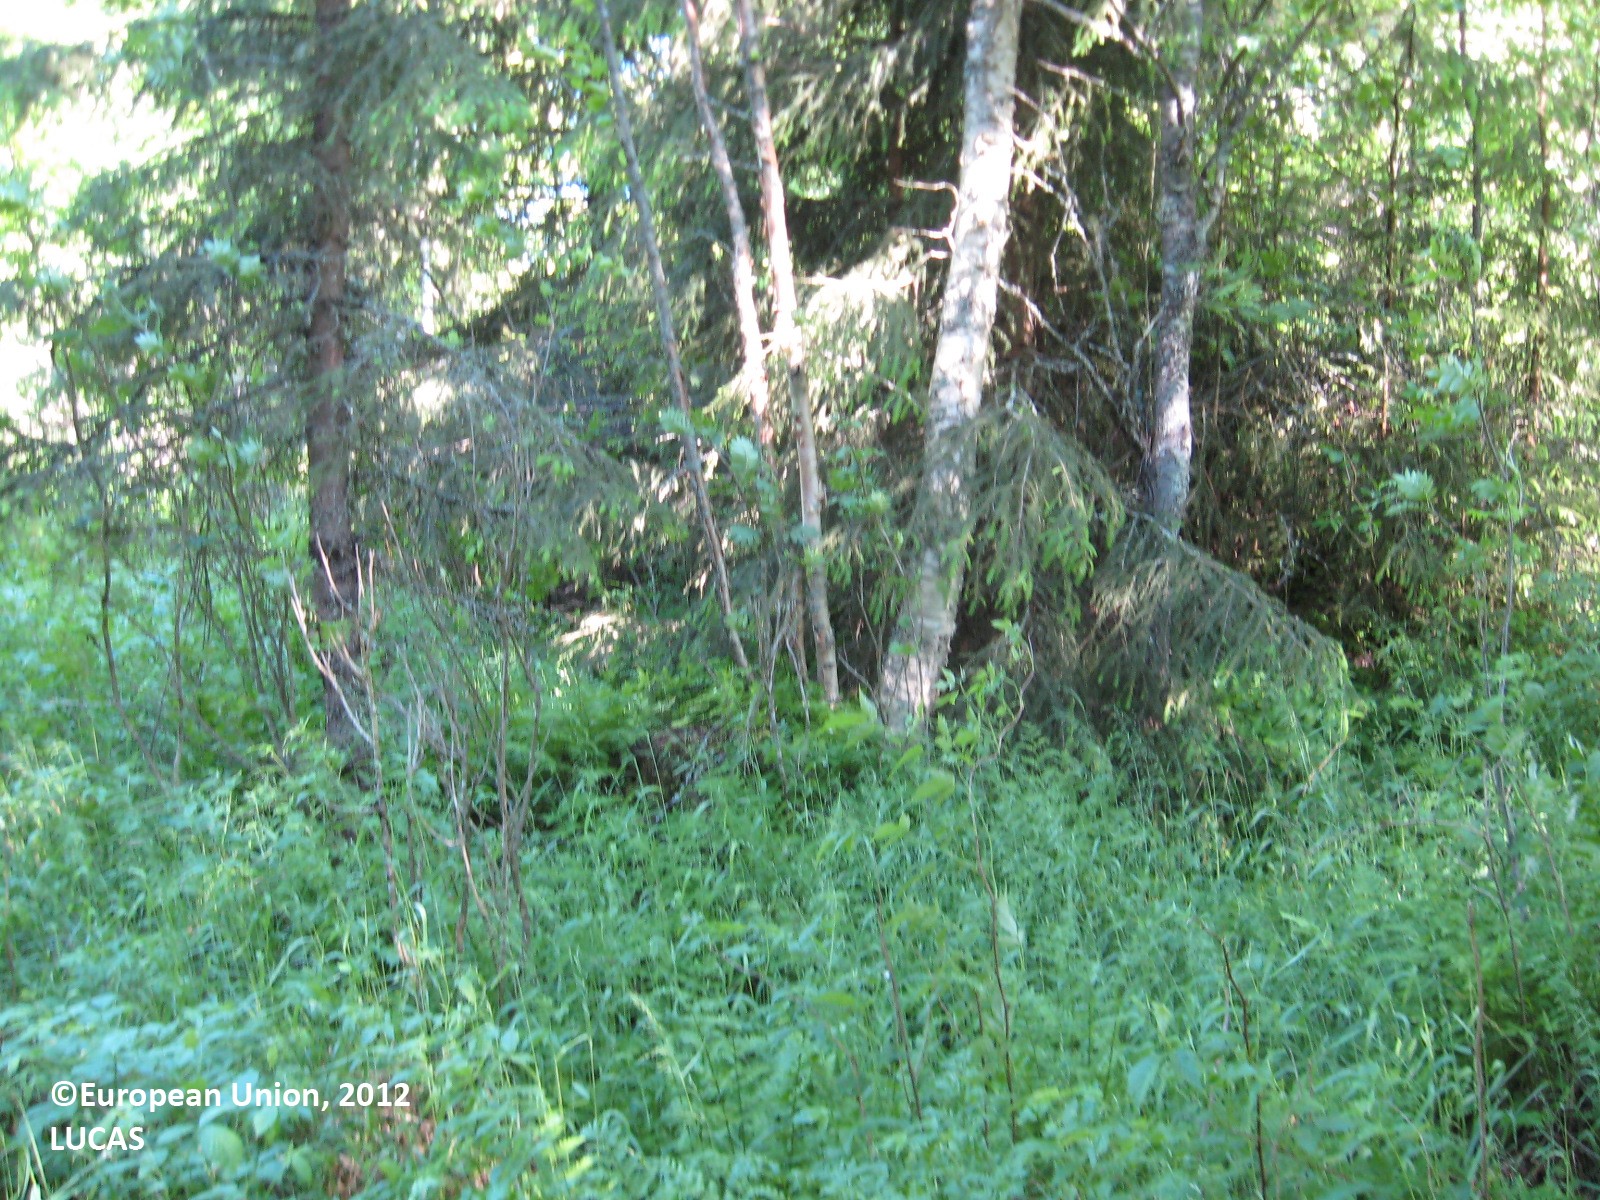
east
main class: Woodland
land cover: Other mixed woodland
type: boreal forest
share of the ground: > 75 %
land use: Forestry
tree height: > 5 m
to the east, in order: Other mixed woodland; Shrubland without tree cover; Ditches and canals; Spruce dominated mixed woodland; Shrubland with sparse tree cover; Electric lines; Shrubland with sparse tree cover; Electric lines; Shrubland with sparse tree cover; Spruce dominated mixed woodland
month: June
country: FI
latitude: 62.9676
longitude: 21.8172
